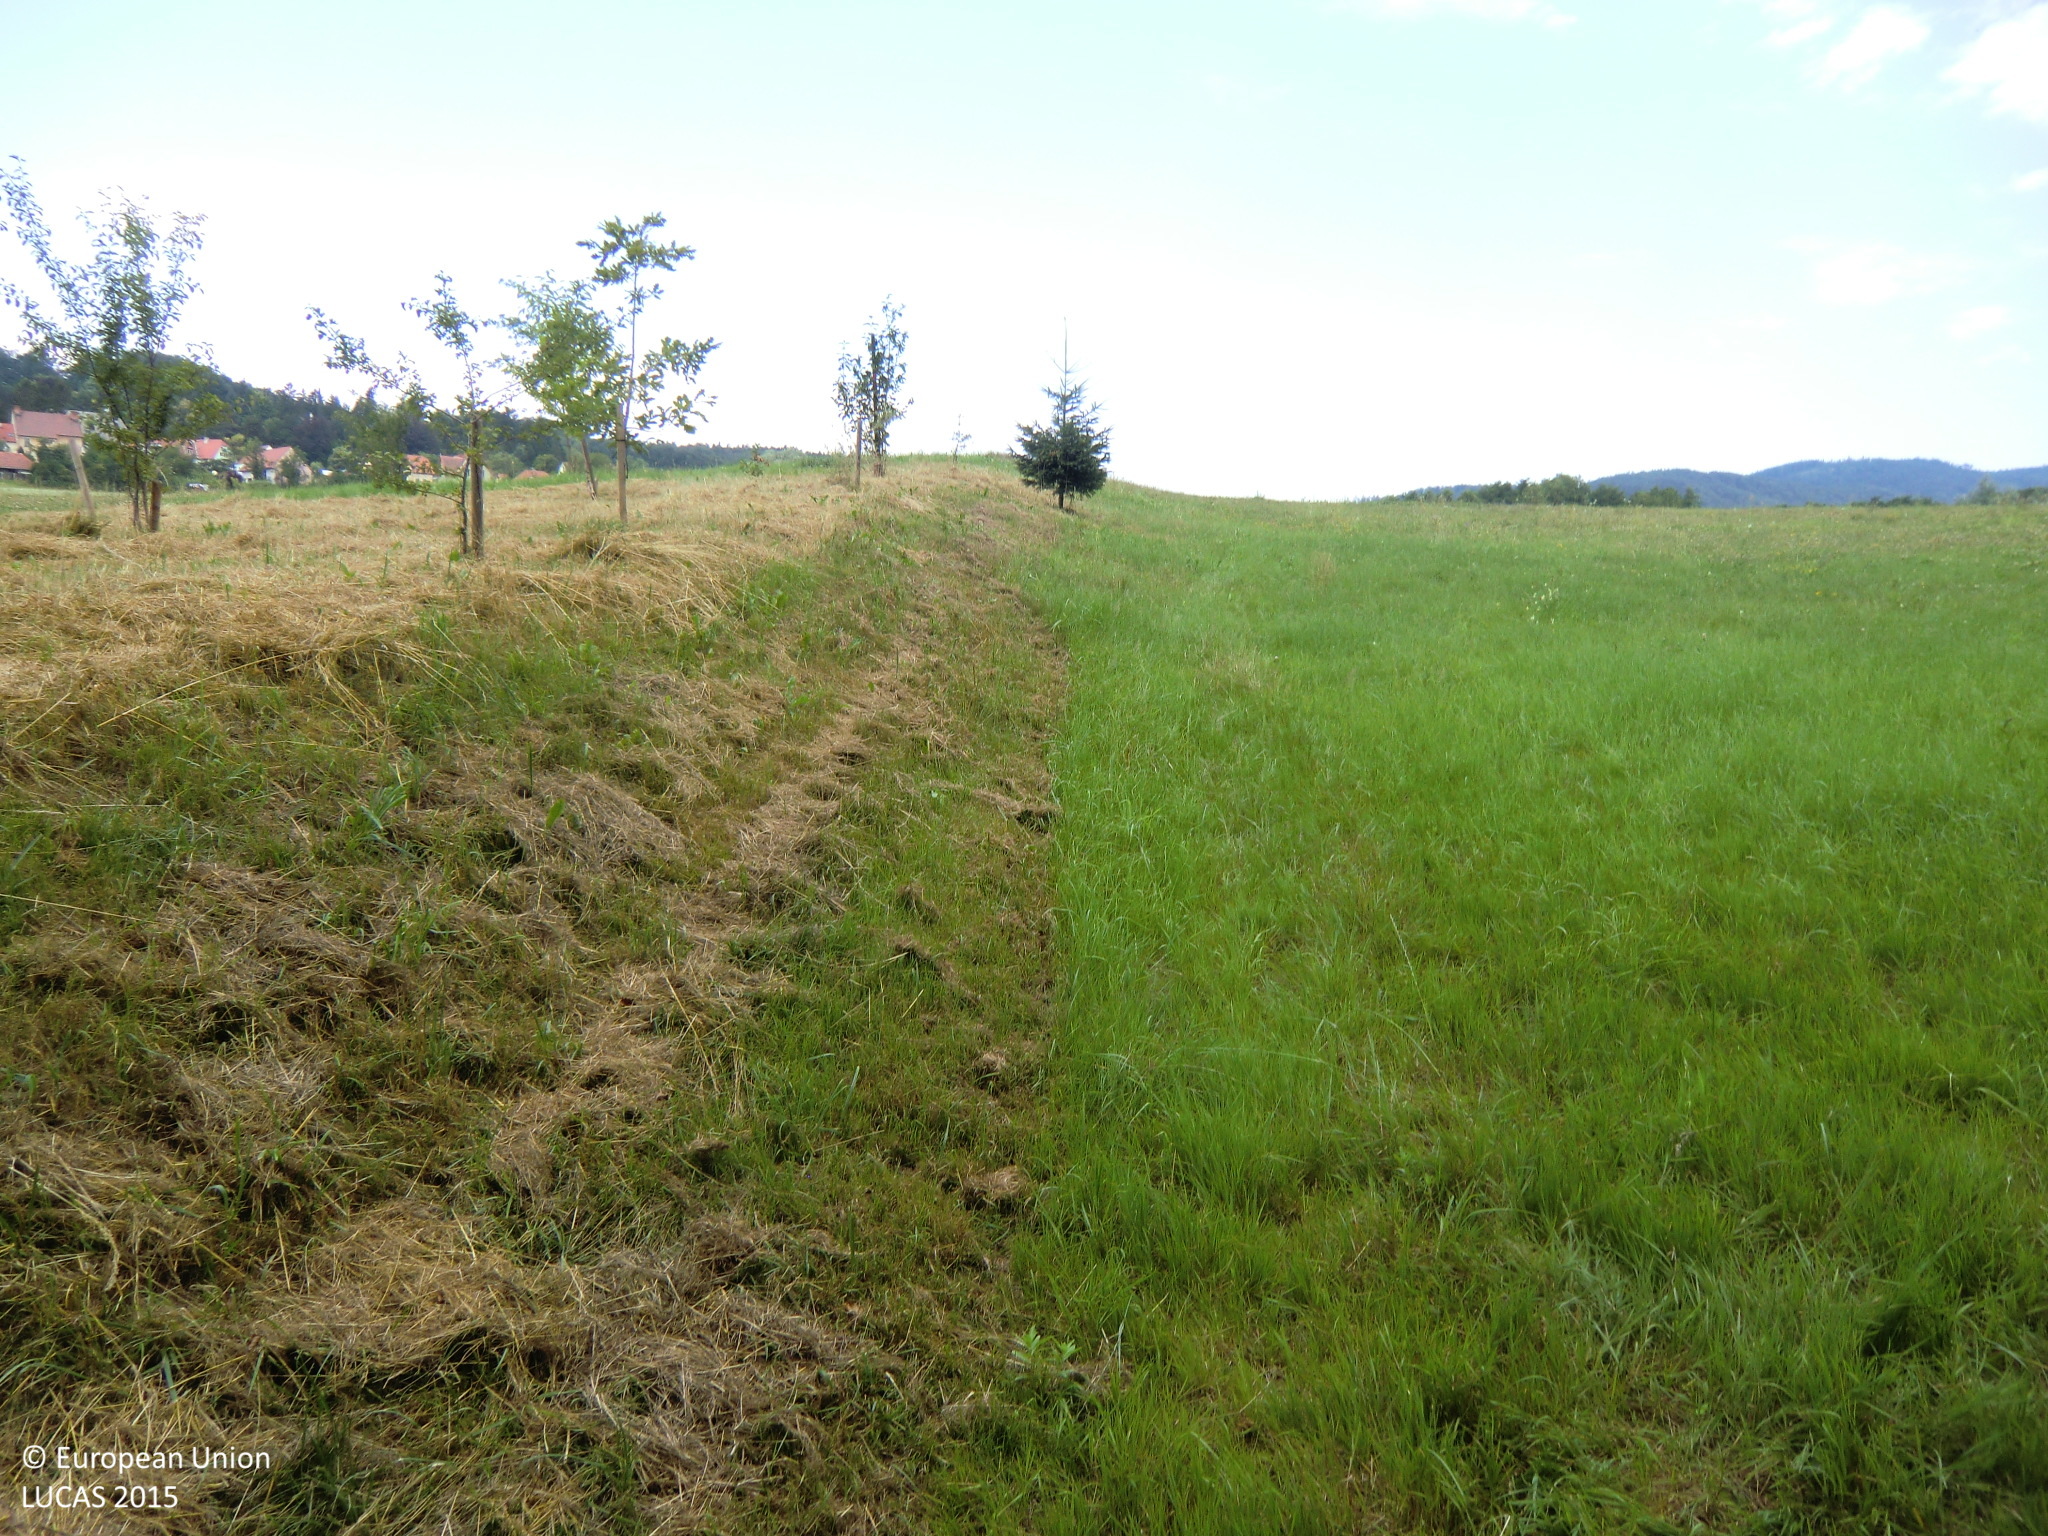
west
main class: Grassland
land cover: Grassland with sparse tree/shrub cover
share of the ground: > 75 %
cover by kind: herbaceous plants 95 %, broadleaved forest trees 5 %
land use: Agriculture (excluding fallow land and kitchen gardens)
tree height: < 5 m
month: July
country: AT
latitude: 47.1163
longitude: 15.4168
